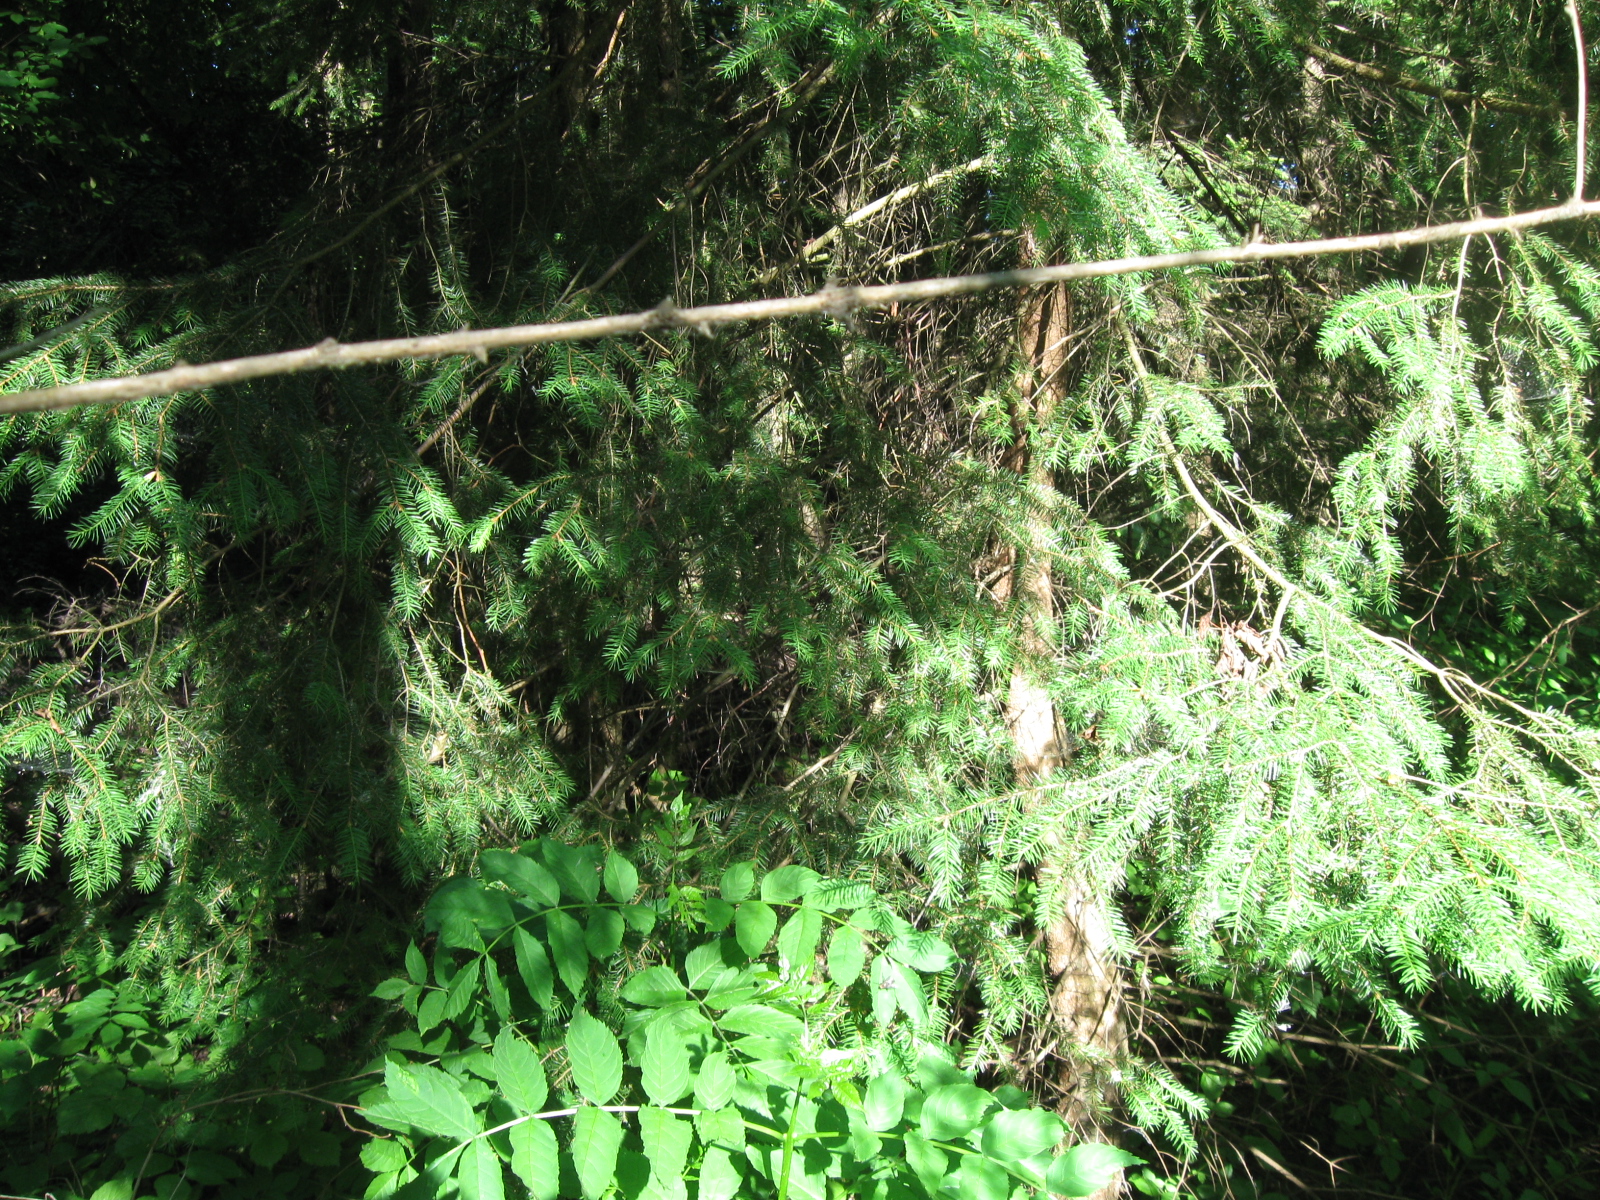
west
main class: Woodland
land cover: Spruce dominated mixed woodland
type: hemiboreal forest and nemoral coniferous forest and mixed broadleaved-coniferous forest
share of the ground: > 75 %
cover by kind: broadleaved forest trees 60 %, coniferous forest trees 30 %, herbaceous plants 10 %
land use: Forestry
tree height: > 5 m
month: June
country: LT
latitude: 54.2885
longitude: 23.6187
